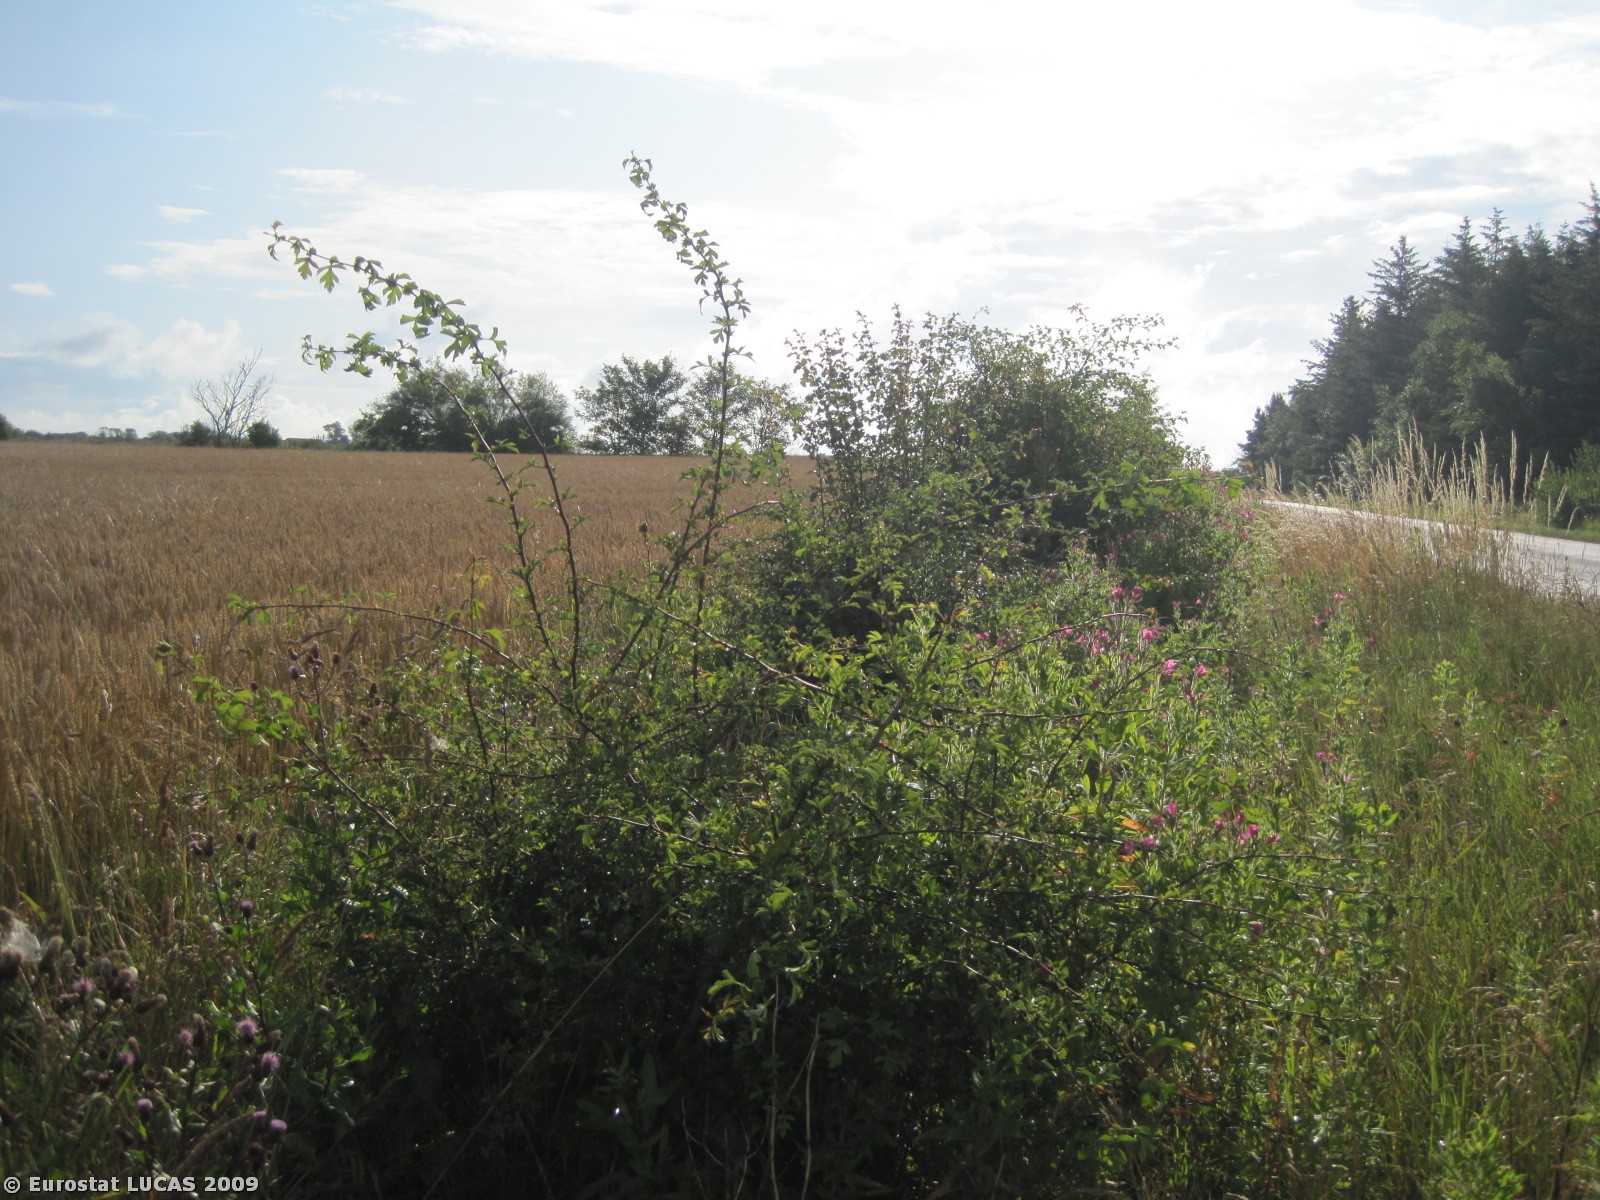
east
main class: Cropland
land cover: Common wheat
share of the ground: > 75 %
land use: Agriculture (excluding fallow land and kitchen gardens)
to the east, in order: Common wheat; Grass margins; Broadleaved woodland; Grass margins; Tracks; Grass margins; Common wheat
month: July
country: DK
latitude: 57.0106
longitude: 8.9641
